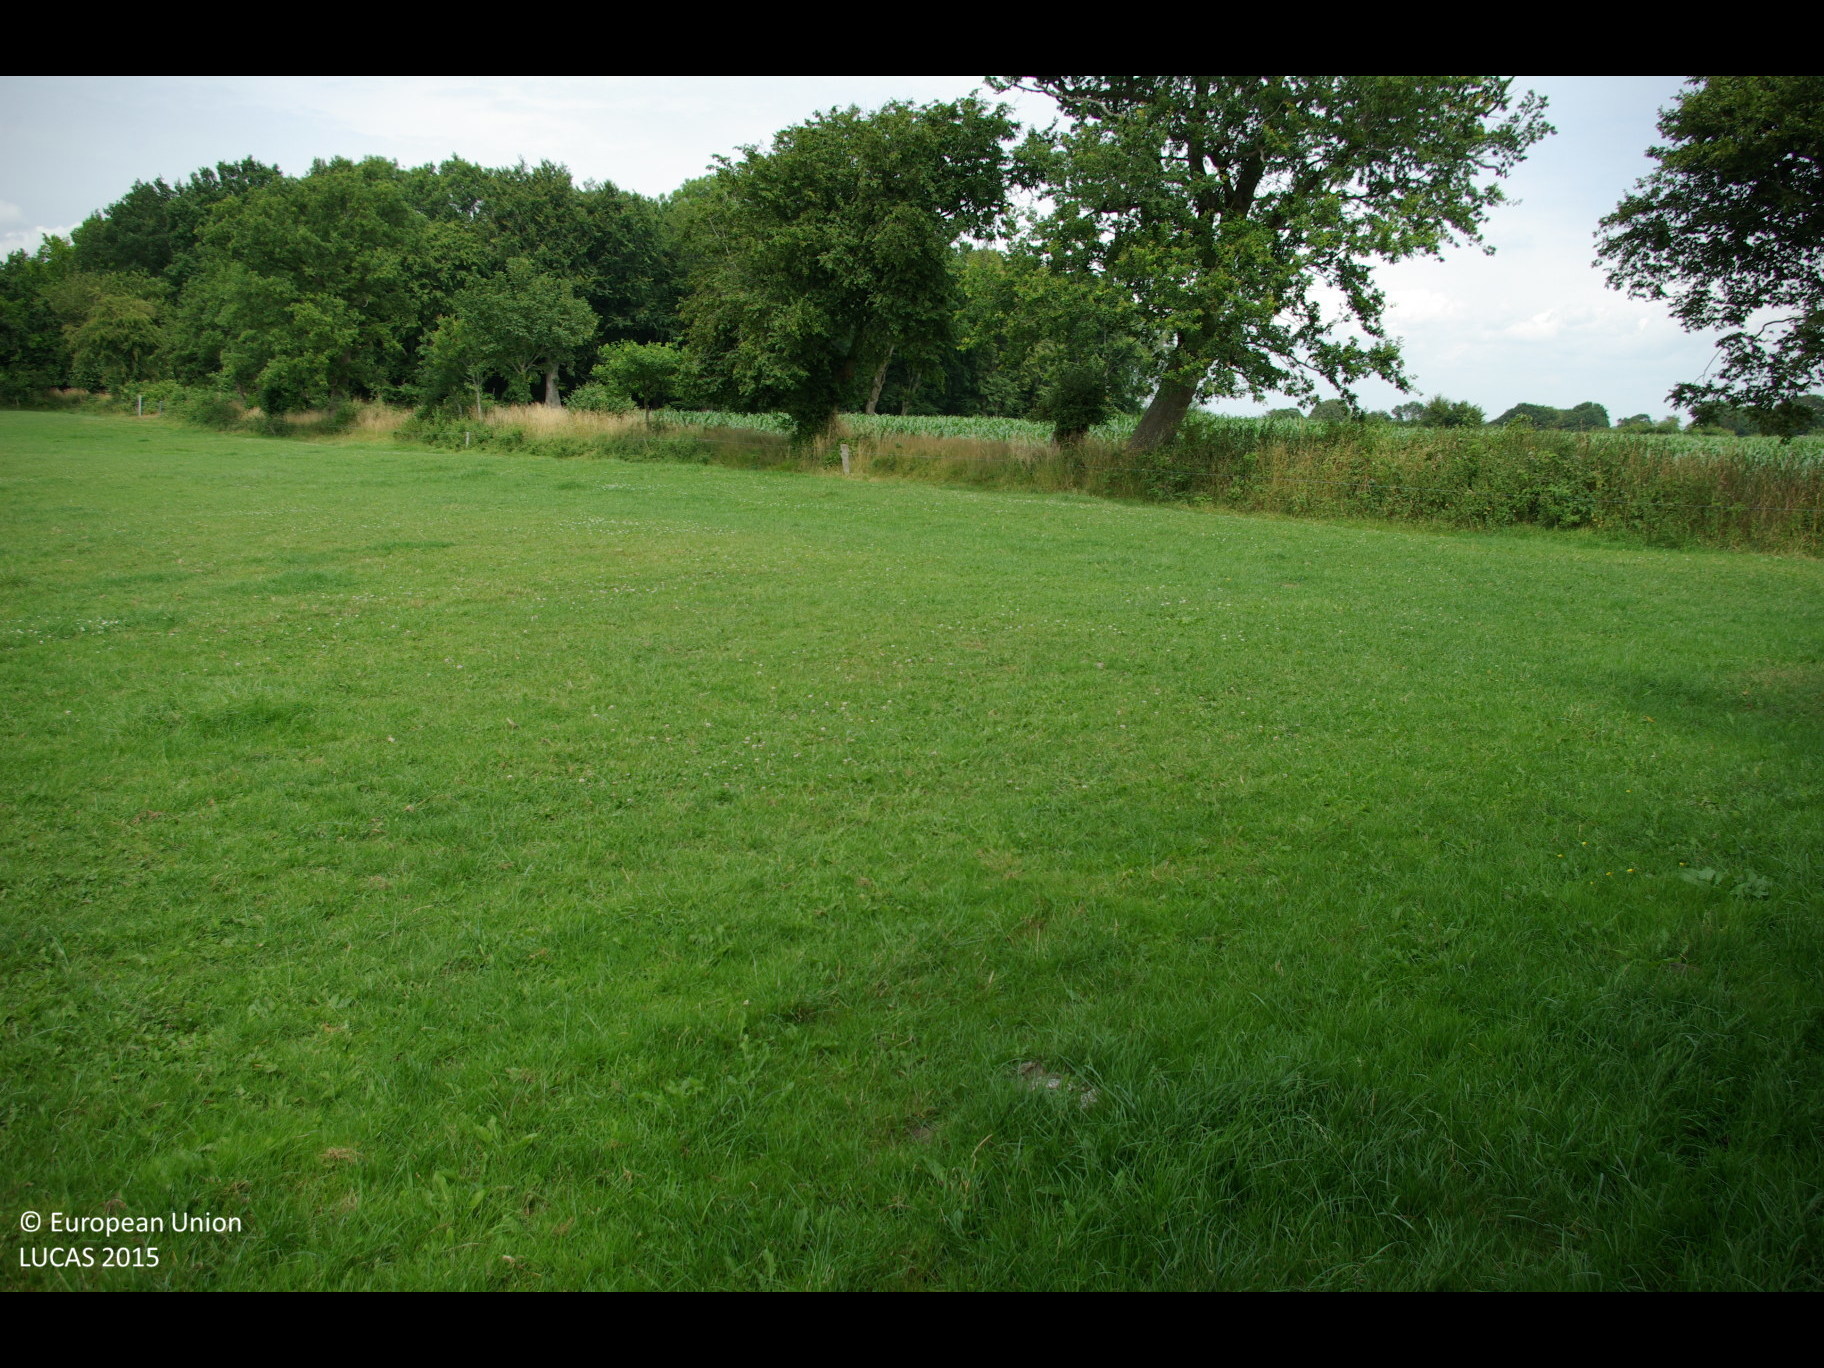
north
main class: Grassland
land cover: Grassland without tree/shrub cover
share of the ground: > 75 %
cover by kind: herbaceous plants 100 %
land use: Agriculture (excluding fallow land and kitchen gardens)
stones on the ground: < 10 %
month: July
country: DE
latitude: 54.2627
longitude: 9.3096
